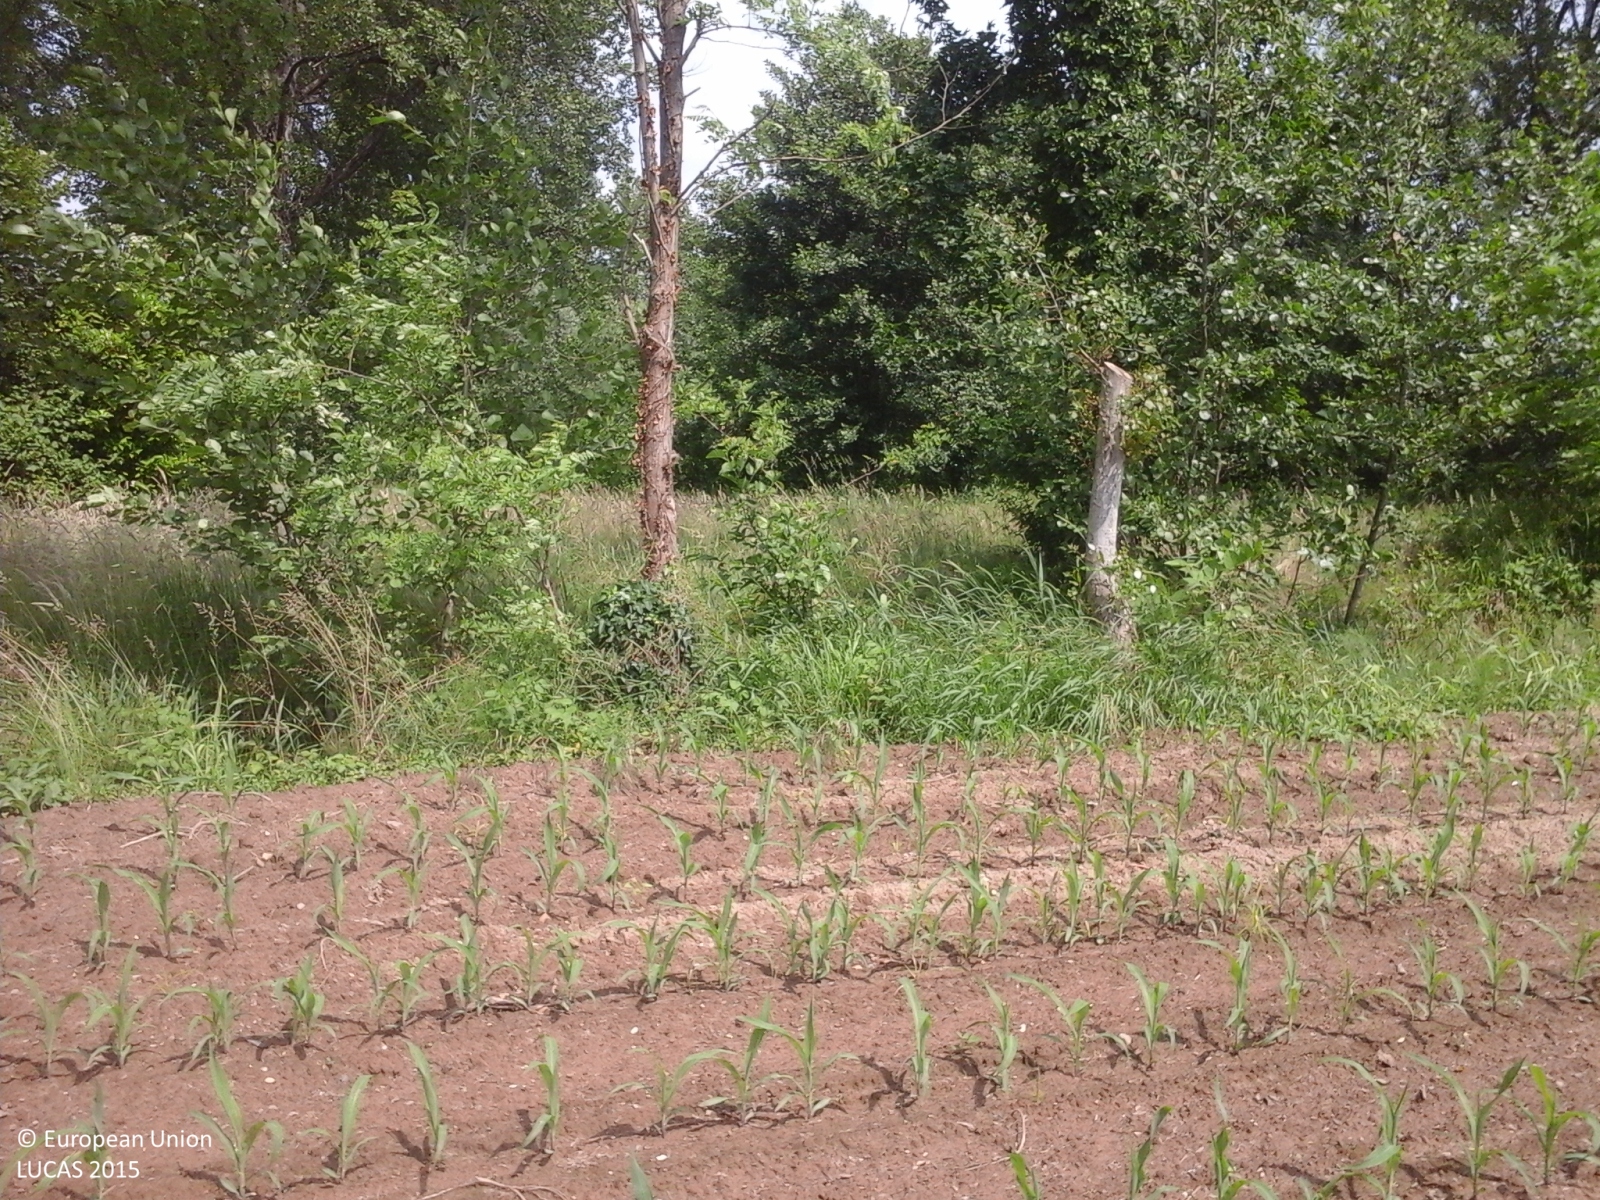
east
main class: Cropland
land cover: Soya
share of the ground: < 10 %
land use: Agriculture (excluding fallow land and kitchen gardens)
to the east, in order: Soya; Grass margins; Managed hedges; Inland fresh running water; Managed hedges; Grass margins; Maize; Abandoned hedges; Ditches and canals; Abandoned hedges; Grassland without tree/shrub cover; Ditches and canals; Grassland without tree/shrub cover; Managed hedges; Ditches and canals; Managed hedges; Grassland without tree/shrub cover; Broadleaved woodland; Ditches and canals; Maize; Electric lines; Maize; Grassland without tree/shrub cover; Tracks; Grassland without tree/shrub cover
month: May
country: IT
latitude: 45.6196
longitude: 11.5237
